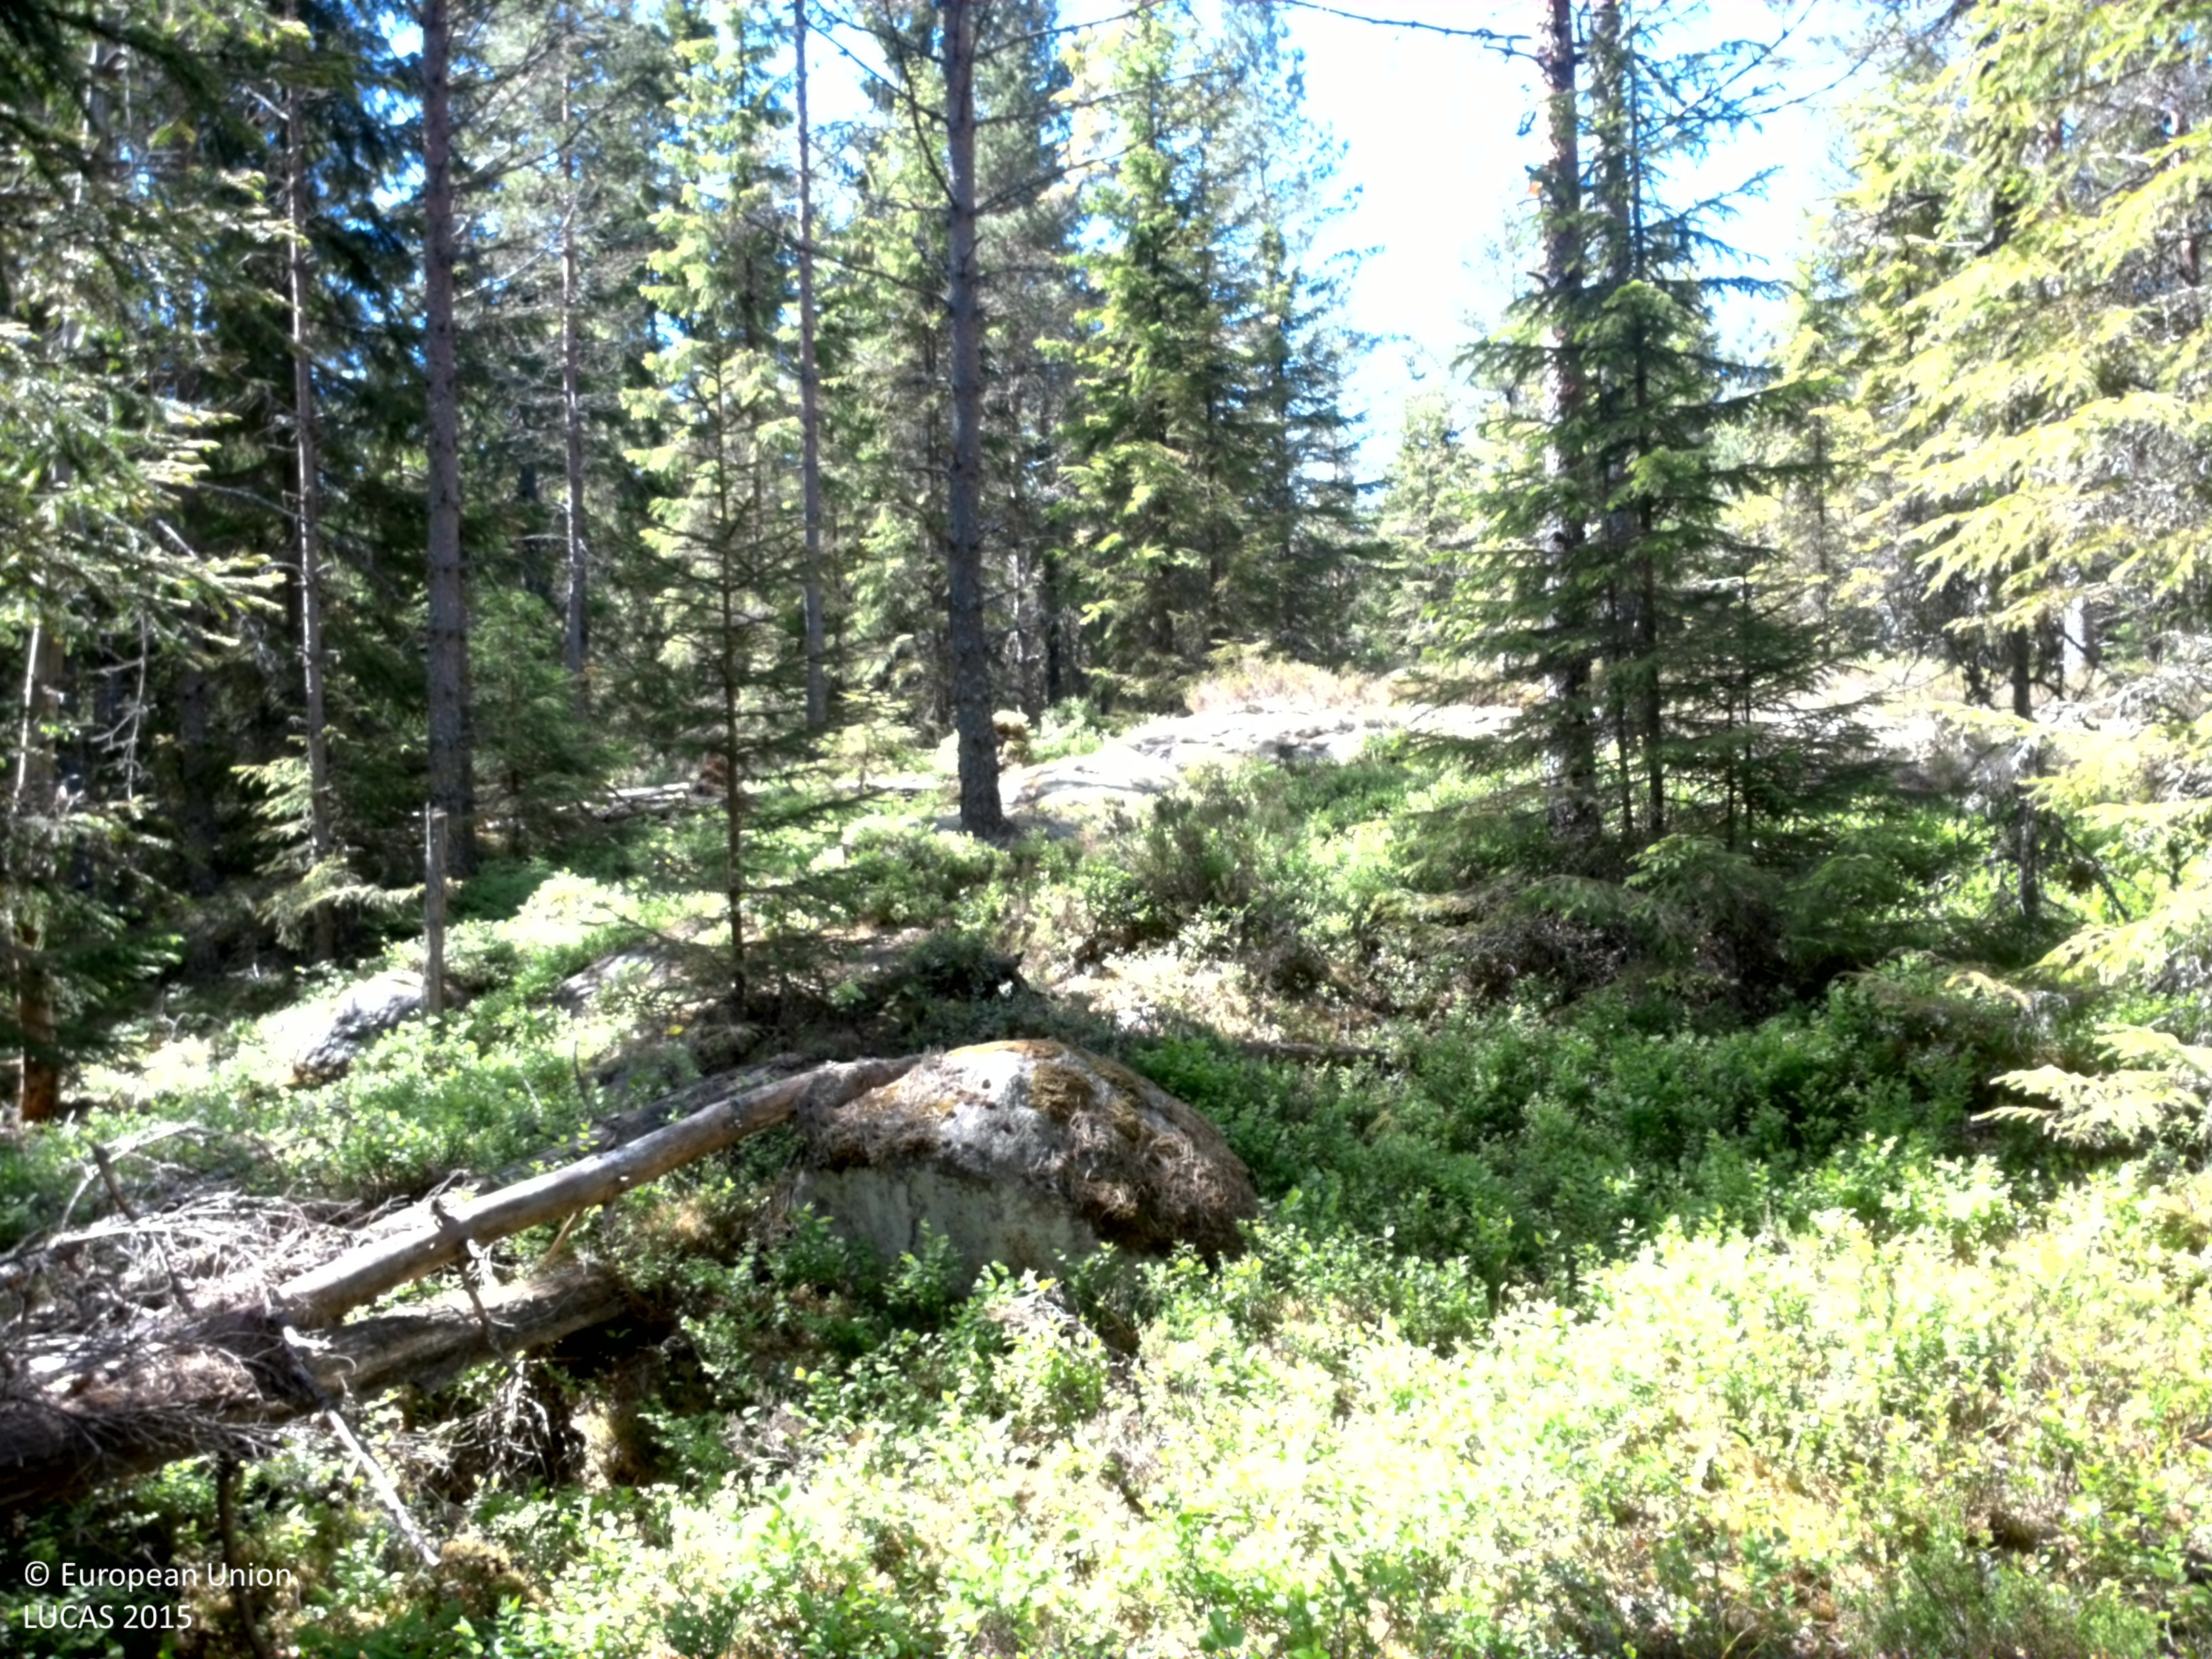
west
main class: Woodland
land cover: Pine dominated coniferous woodland
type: boreal forest
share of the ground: > 75 %
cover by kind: coniferous forest trees 75 %, shrubs 15 %, broadleaved forest trees 5 %, herbaceous plants 5 %
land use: Forestry
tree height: > 5 m
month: June
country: SE
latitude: 59.5893
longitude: 12.0667
